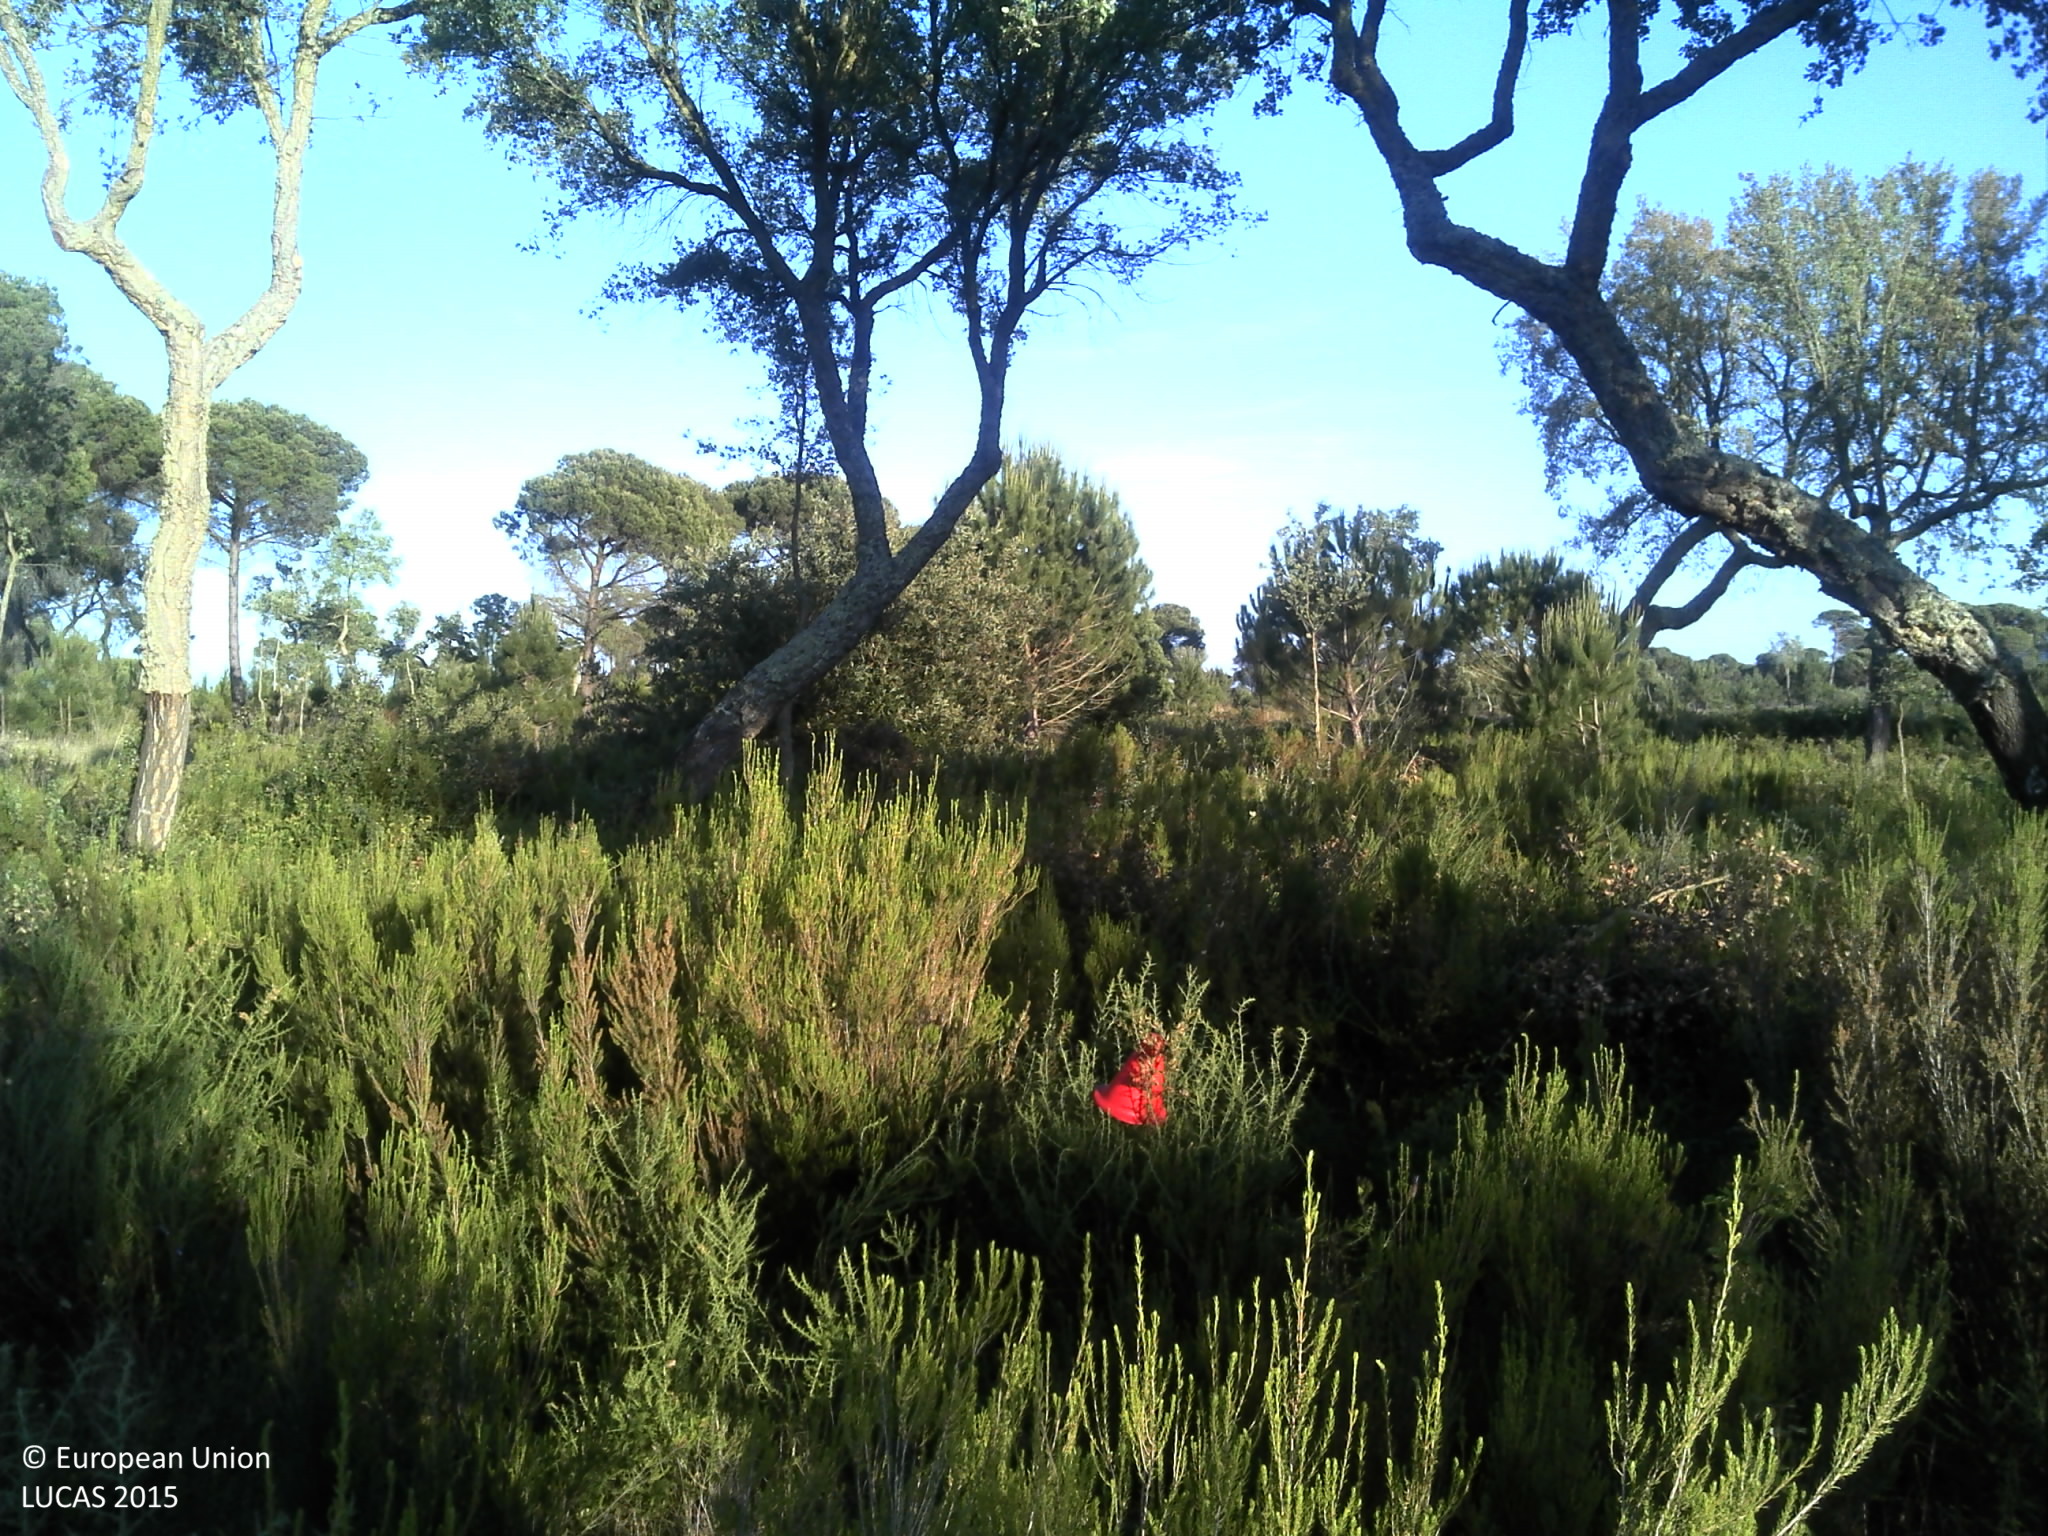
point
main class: Woodland
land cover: Broadleaved woodland
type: broadleaved evergreen forest
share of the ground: 25 - 50 %
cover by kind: broadleaved forest trees 60 %, shrubs 30 %, herbaceous plants 5 %, unconsolidated bare surface 5 %
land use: Forestry
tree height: > 5 m
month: May
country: PT
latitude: 38.2231
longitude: -8.6358
